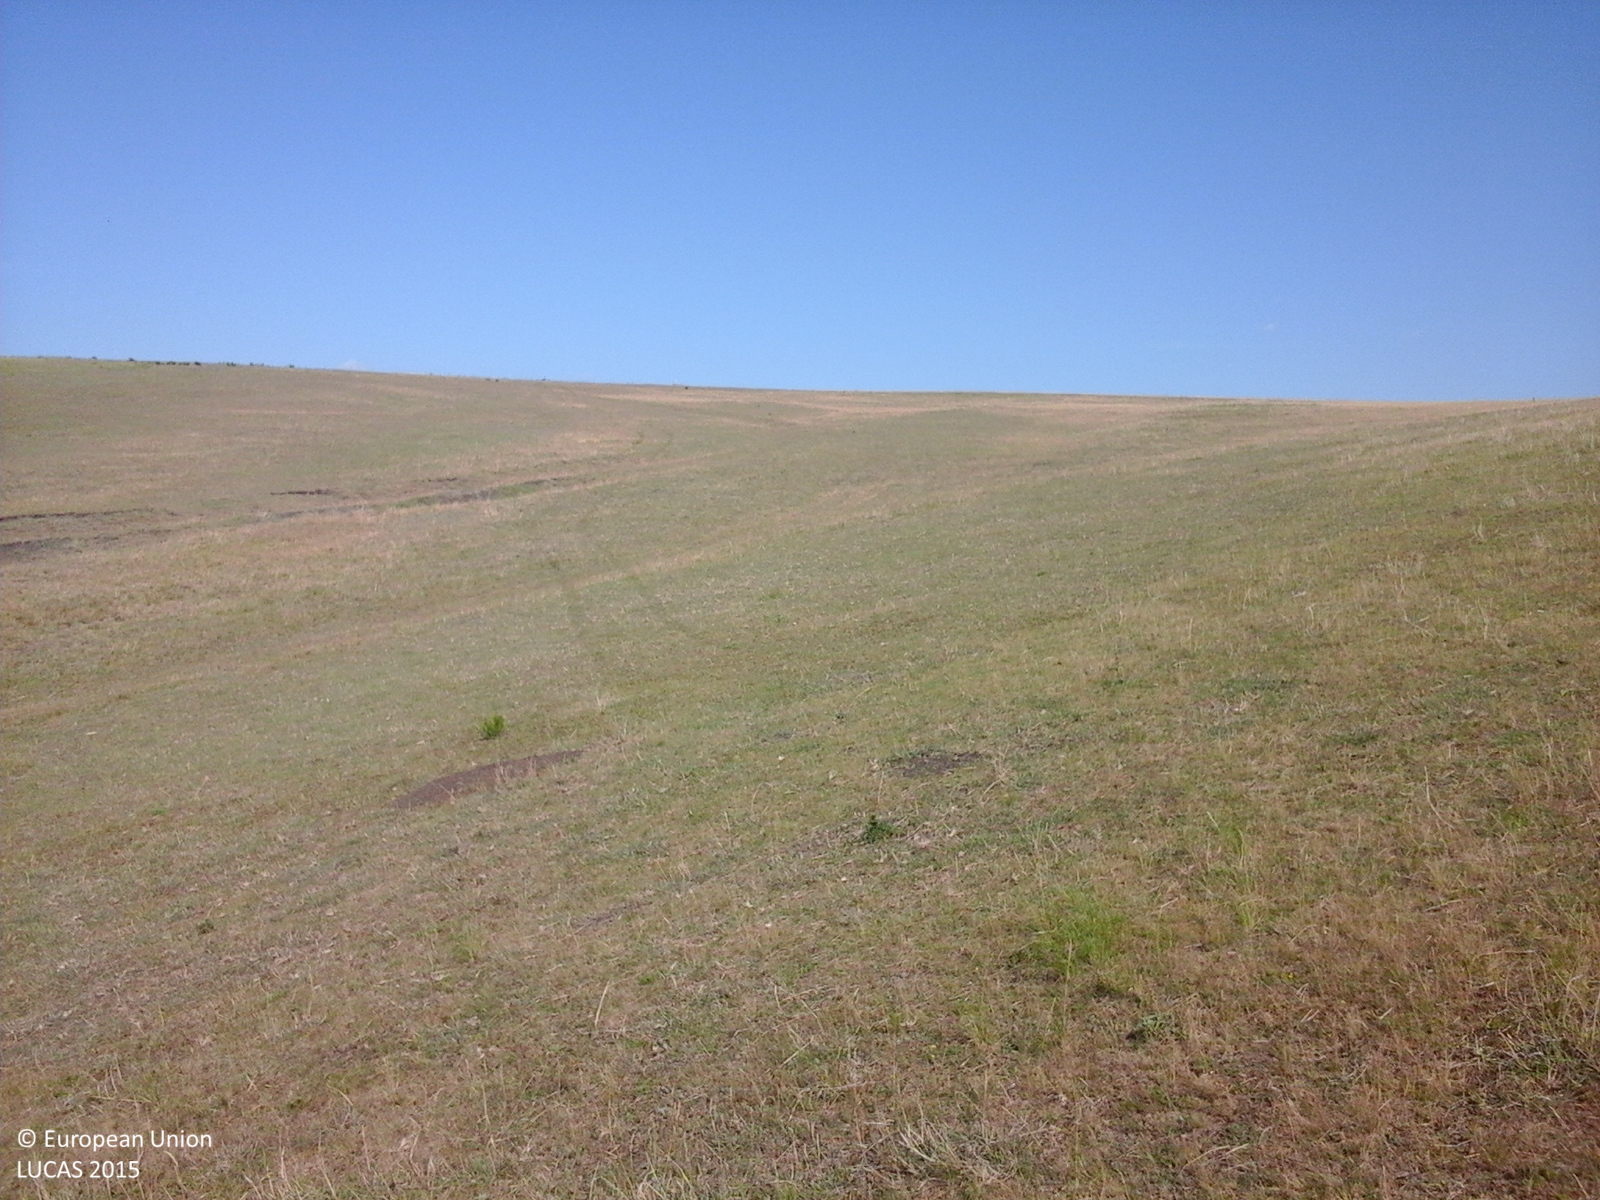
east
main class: Grassland
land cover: Grassland without tree/shrub cover
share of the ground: > 75 %
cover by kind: herbaceous plants 100 %
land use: Agriculture (excluding fallow land and kitchen gardens)
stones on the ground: < 10 %
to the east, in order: Grassland without tree/shrub cover; Tracks; Temporary grasslands
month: June
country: RO
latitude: 47.3290
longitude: 27.2452
